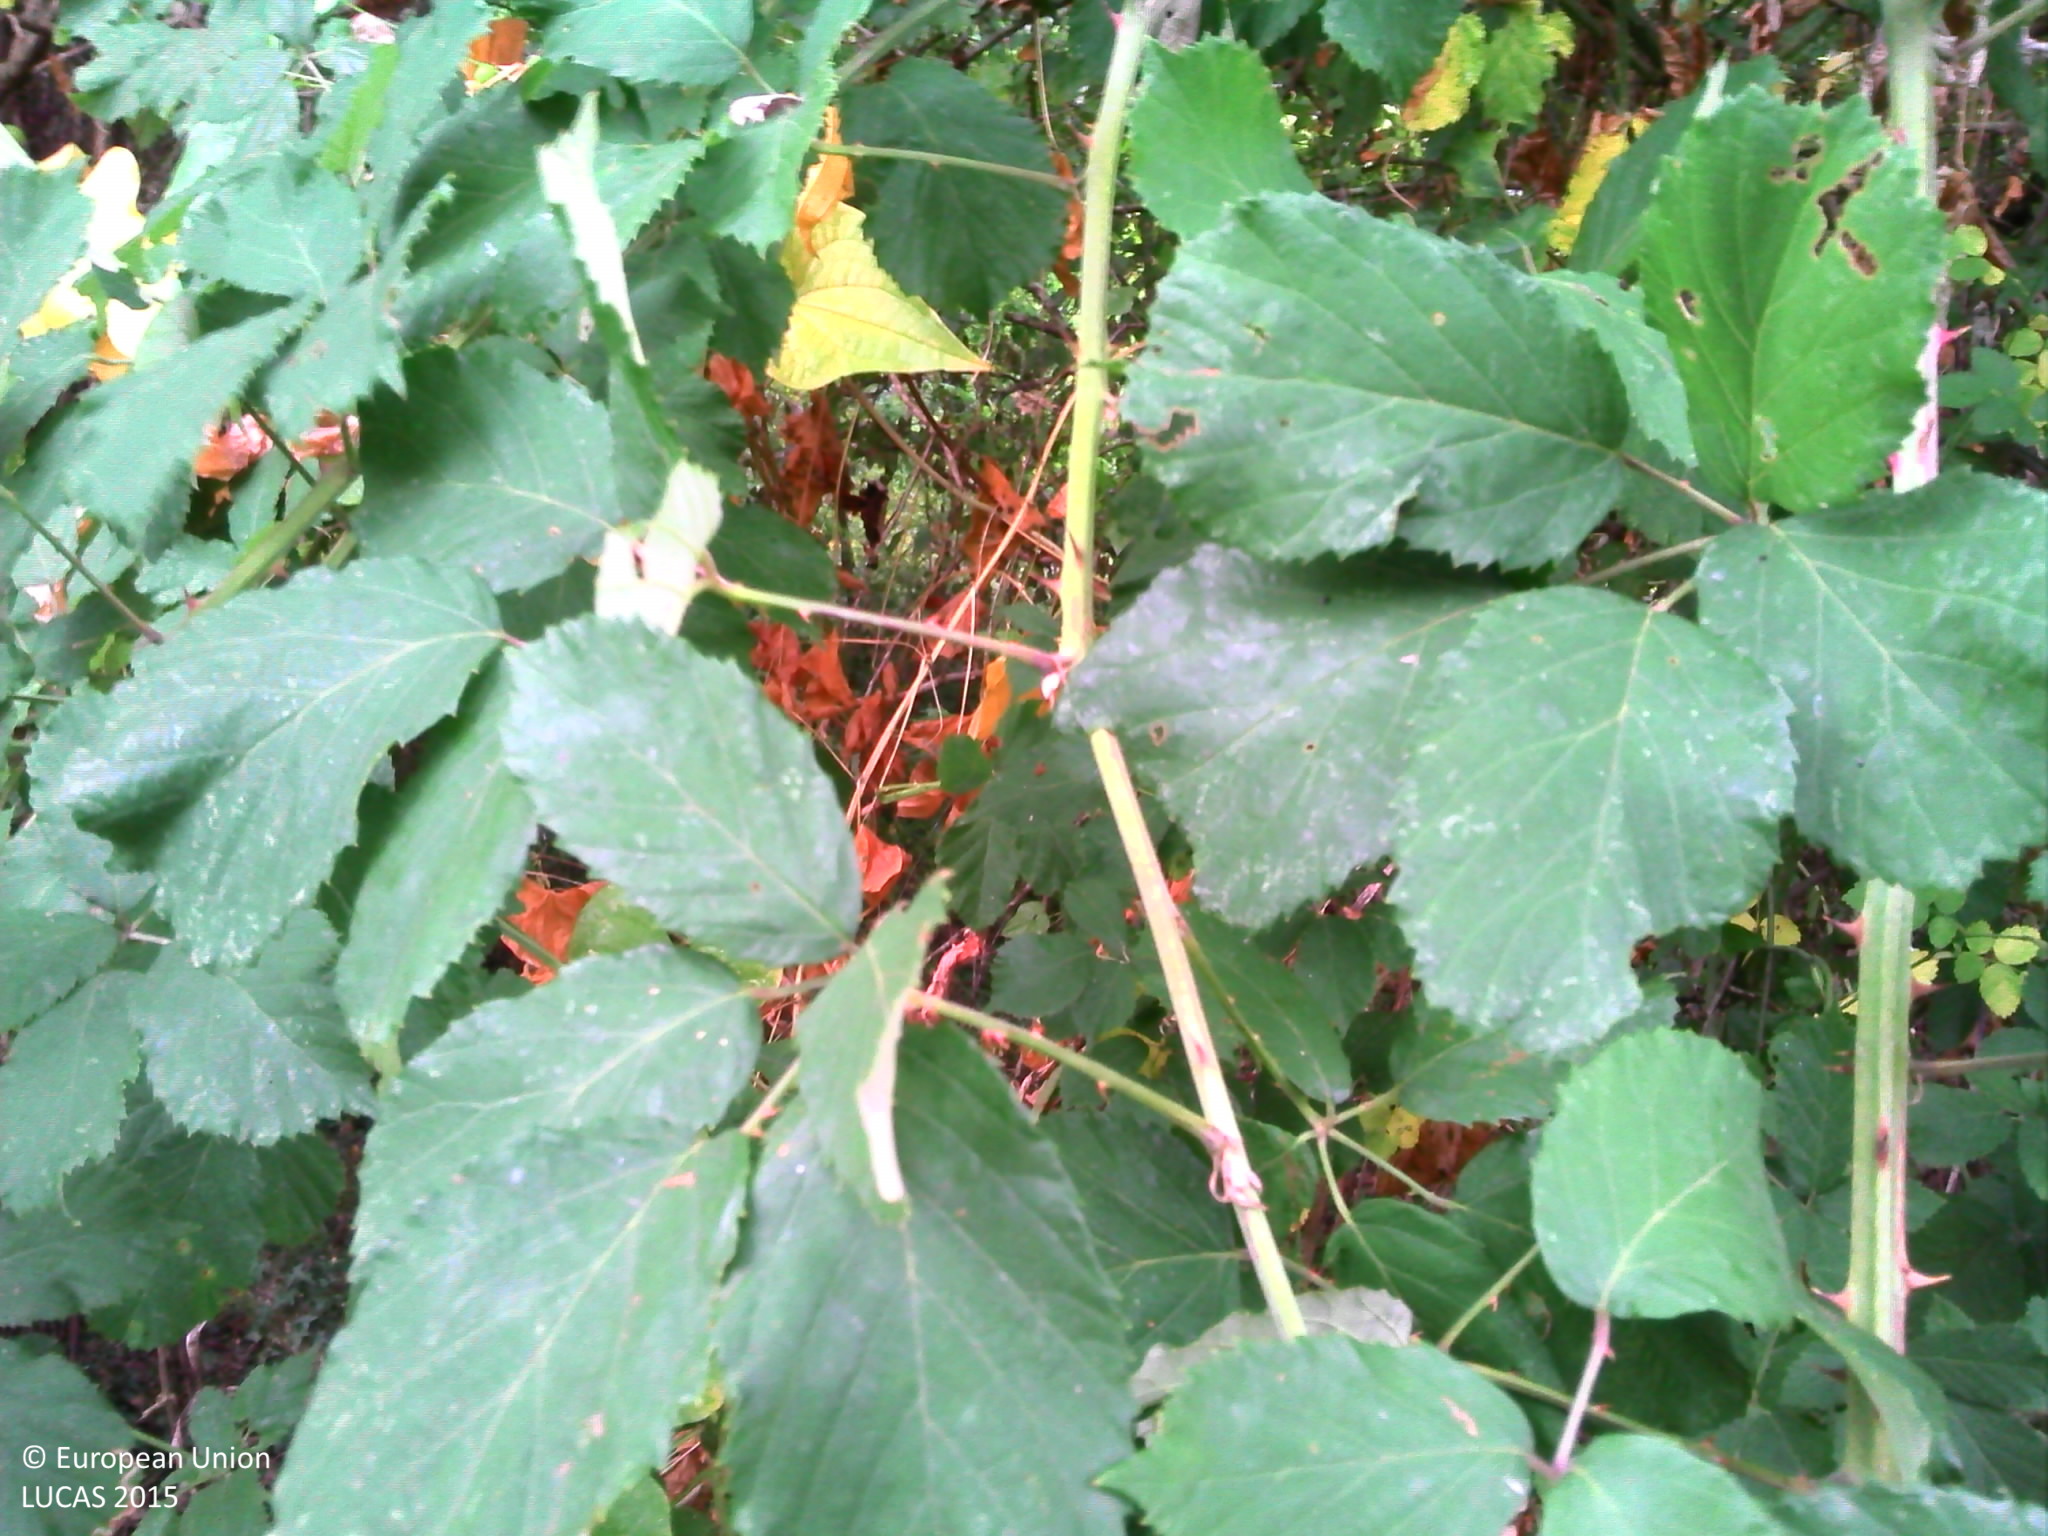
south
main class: Woodland
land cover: Broadleaved woodland
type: mesophytic deciduous forest
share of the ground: > 75 %
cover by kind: broadleaved forest trees 50 %, herbaceous plants 25 %, shrubs 20 %, lichens and mosses 5 %
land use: Forestry
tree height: > 5 m
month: July
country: FR
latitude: 44.9121
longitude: 0.5028
